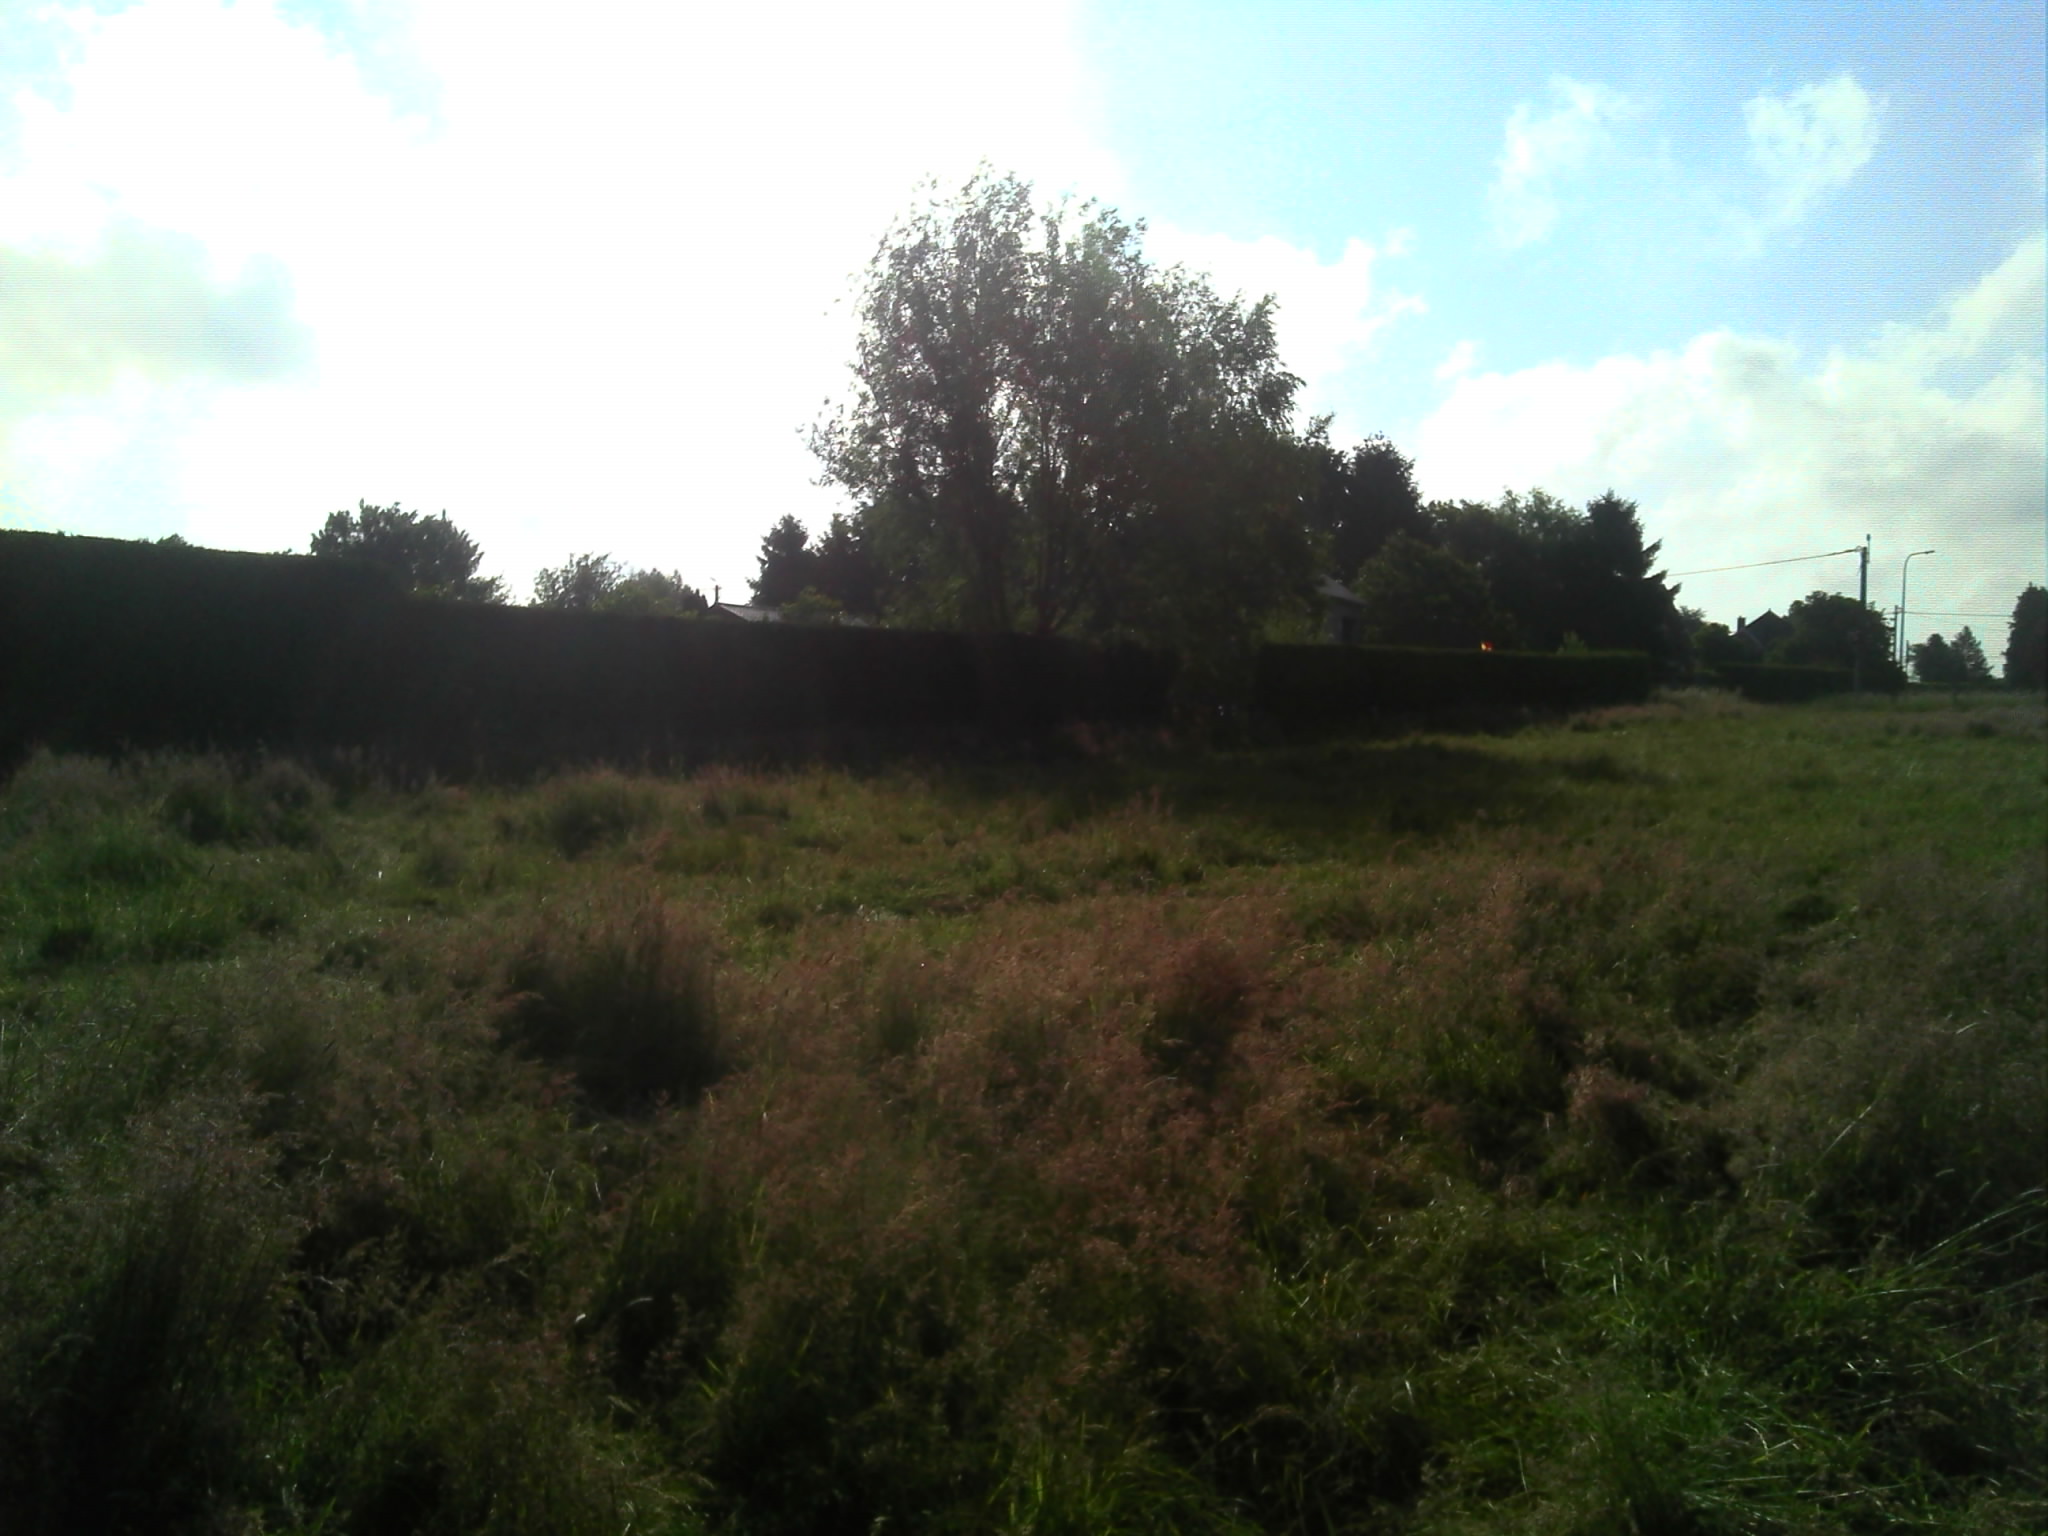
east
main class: Grassland
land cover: Grassland without tree/shrub cover
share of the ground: > 75 %
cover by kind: herbaceous plants 100 %
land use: Agriculture (excluding fallow land and kitchen gardens)
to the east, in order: Grassland without tree/shrub cover; Artificial constructions in urban areas; Grassland without tree/shrub cover; Artificial constructions in urban areas; Grassland without tree/shrub cover; Artificial constructions in urban areas
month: June
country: BE
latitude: 50.3903
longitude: 4.8065
